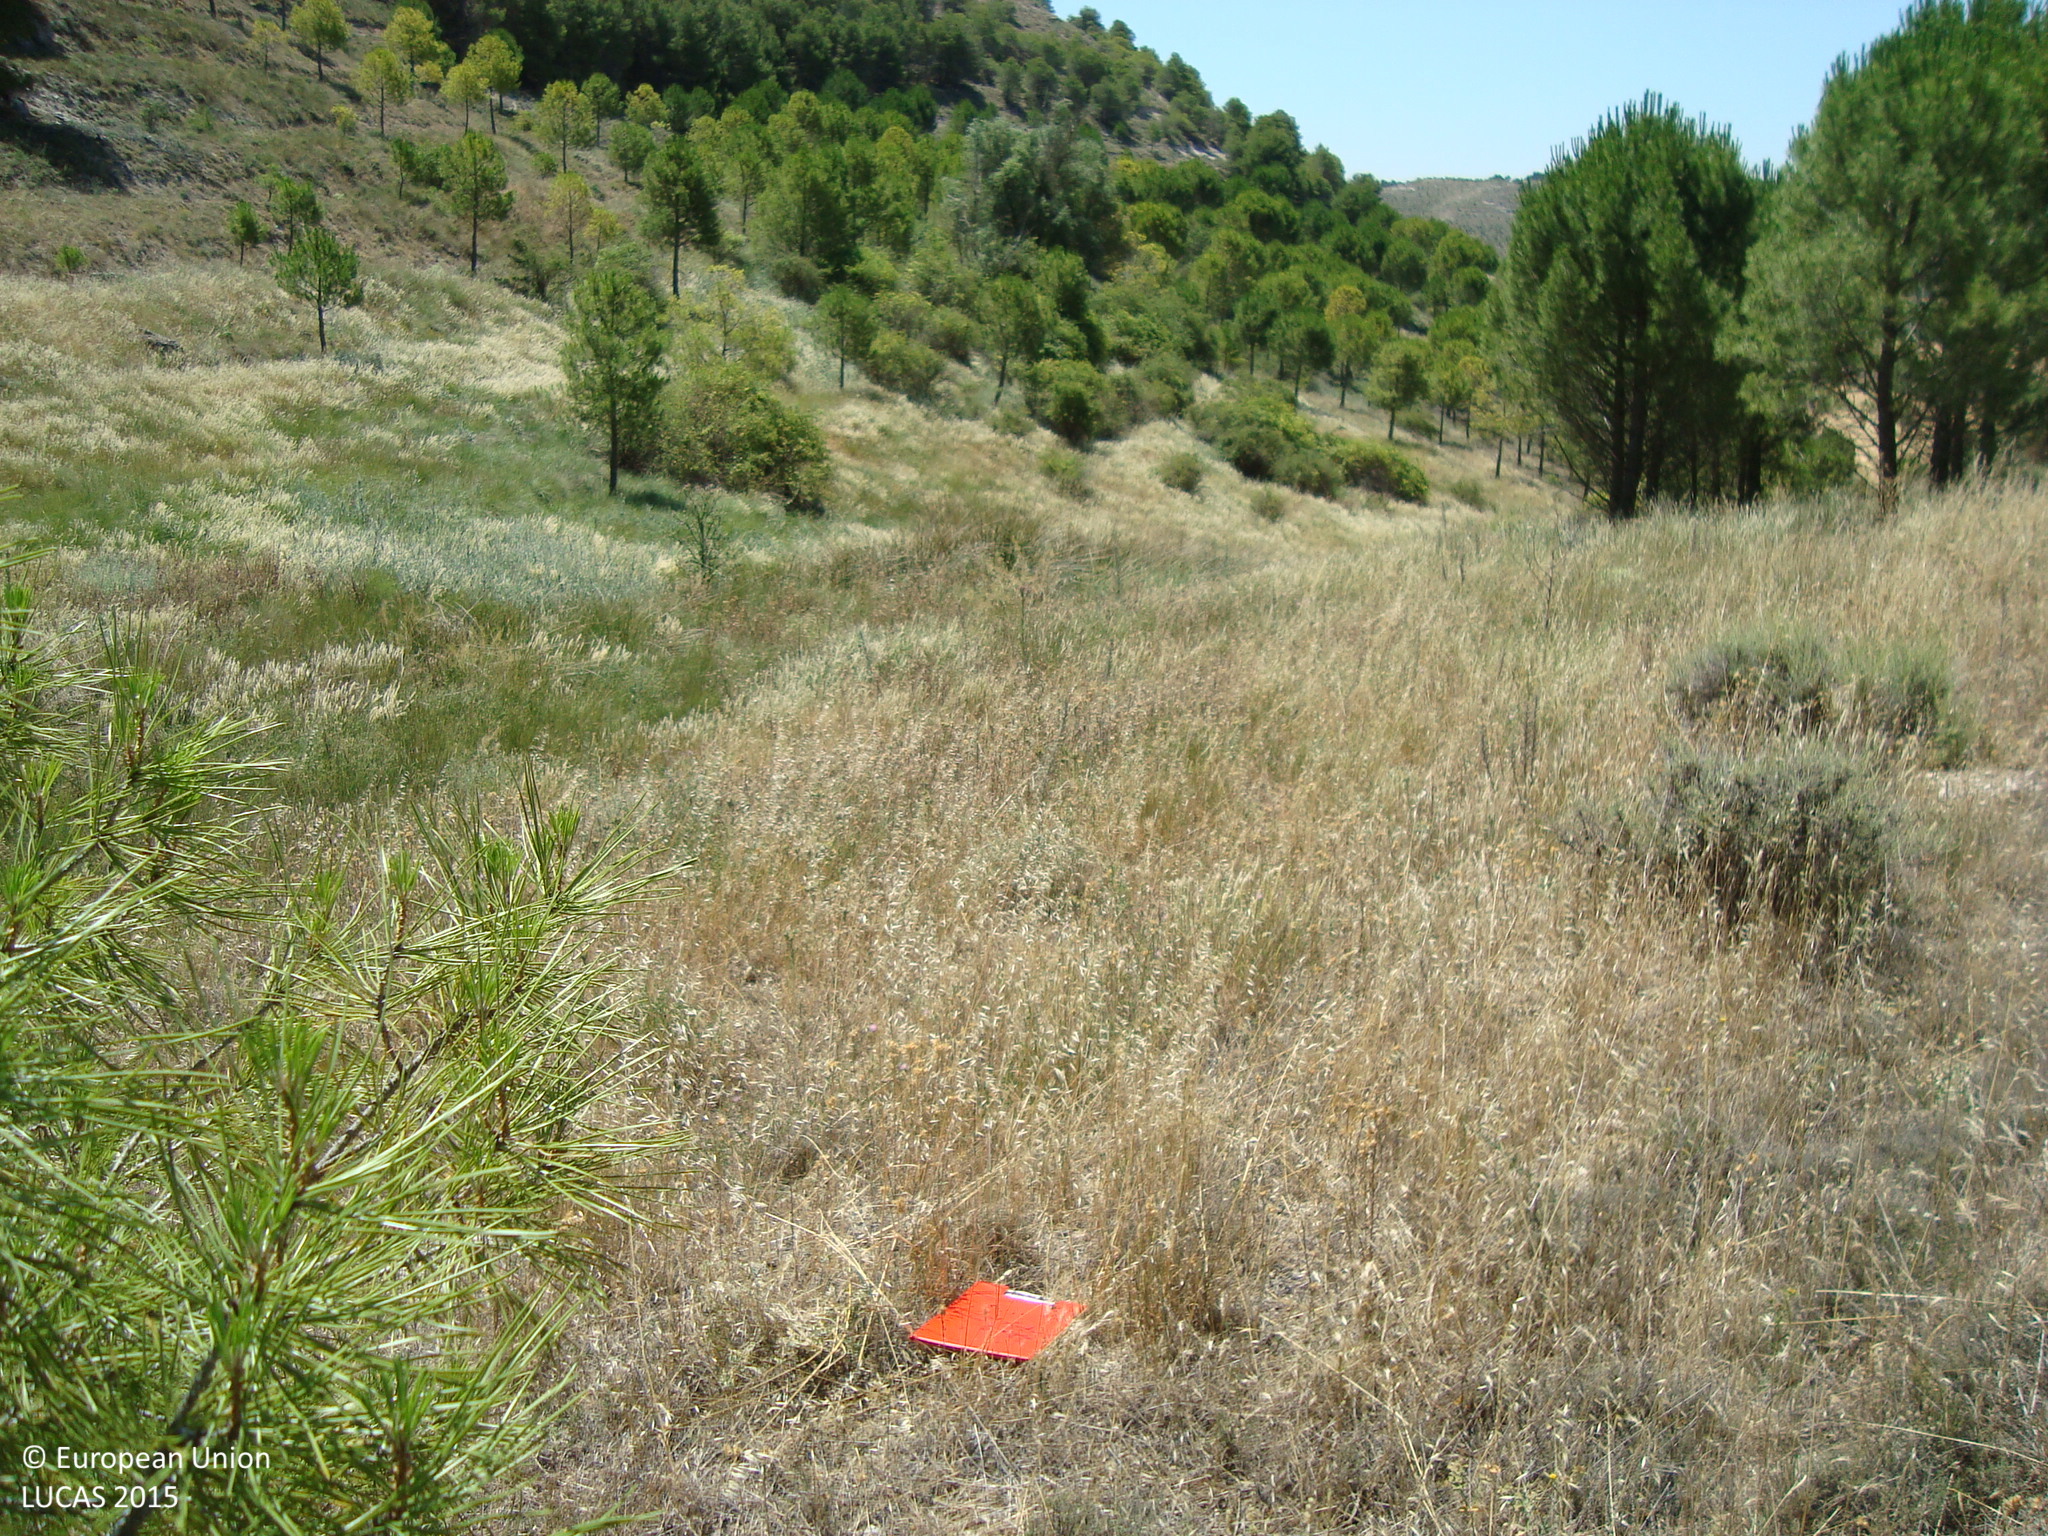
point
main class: Woodland
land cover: Pine dominated coniferous woodland
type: coniferous forest of the mediterranean region
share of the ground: 10 - 25 %
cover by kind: herbaceous plants 75 %, coniferous forest trees 15 %, shrubs 10 %
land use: Semi-natural and natural areas not in use
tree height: < 5 m
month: July
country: ES
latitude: 41.6590
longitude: -4.1216
